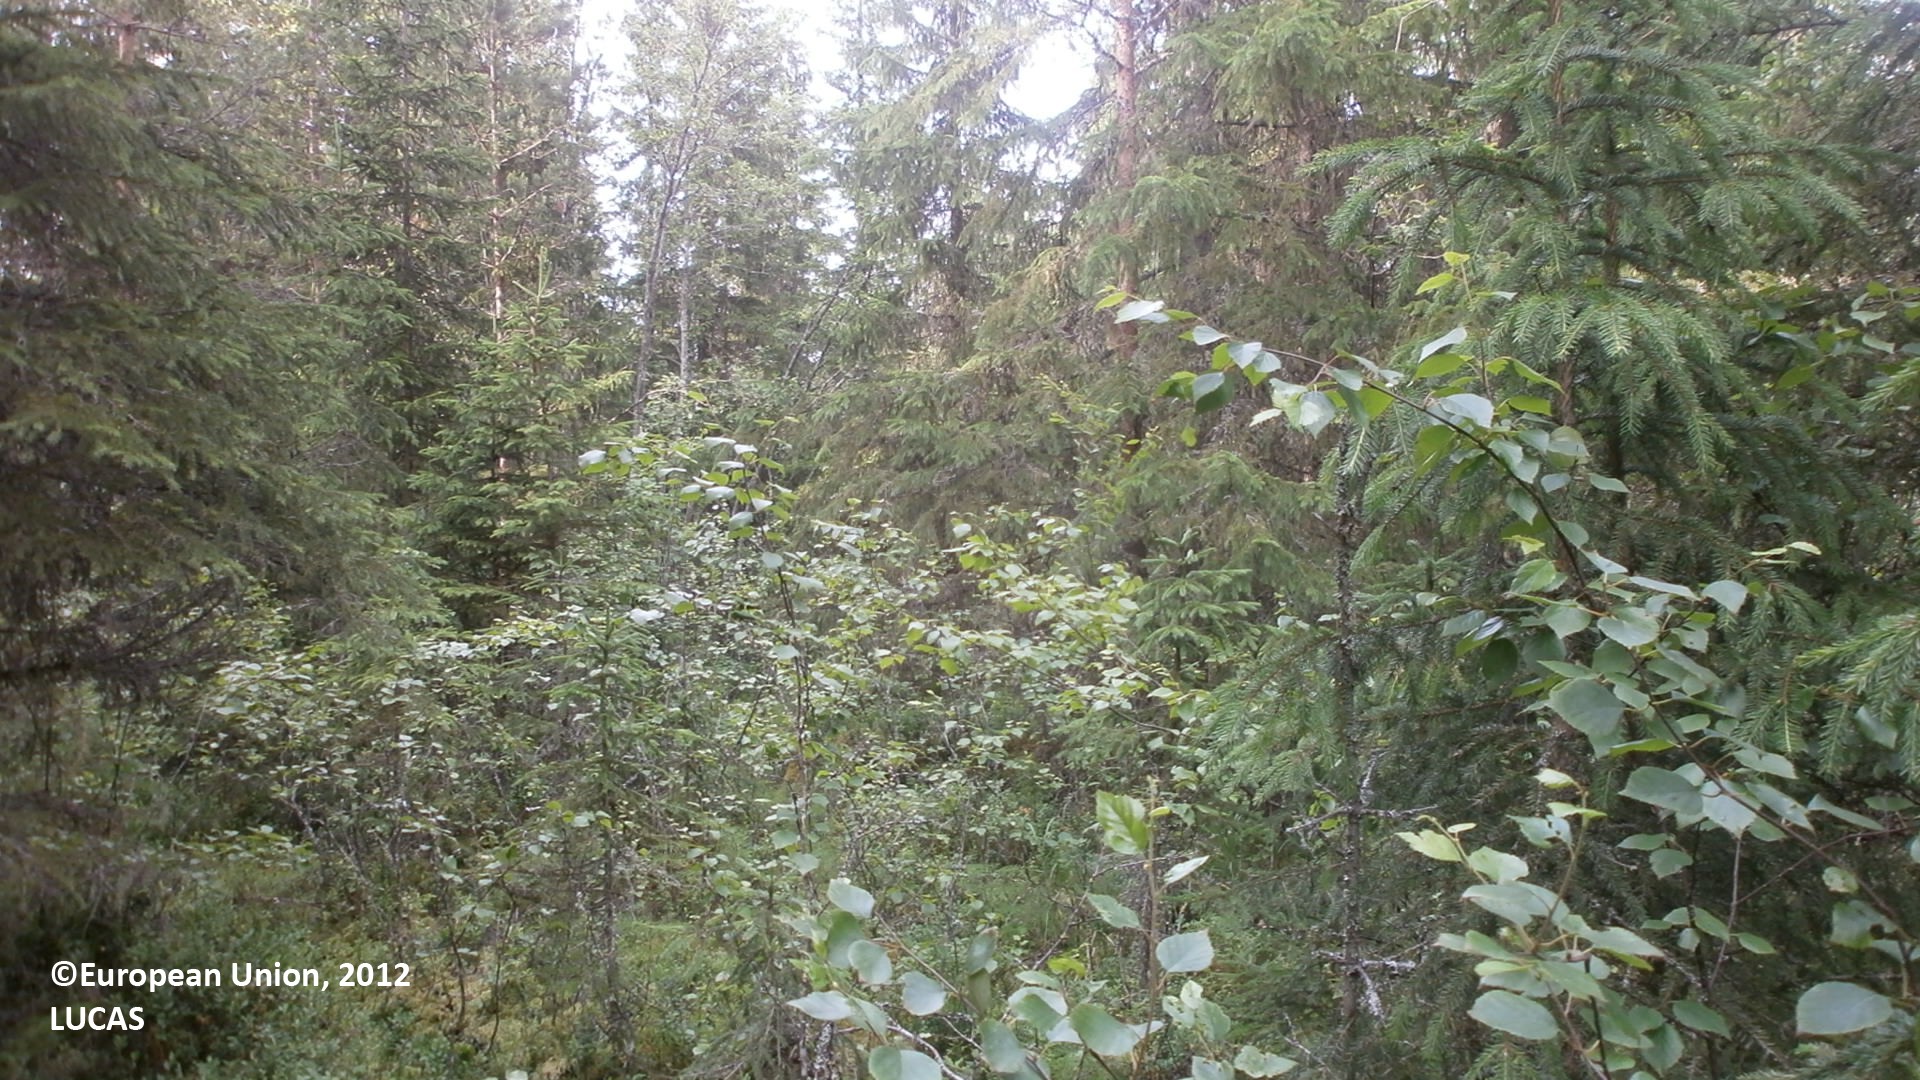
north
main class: Woodland
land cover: Spruce dominated mixed woodland
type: boreal forest
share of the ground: 50 - 75 %
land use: Forestry
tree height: > 5 m
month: July
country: FI
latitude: 64.3369
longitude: 24.2846
